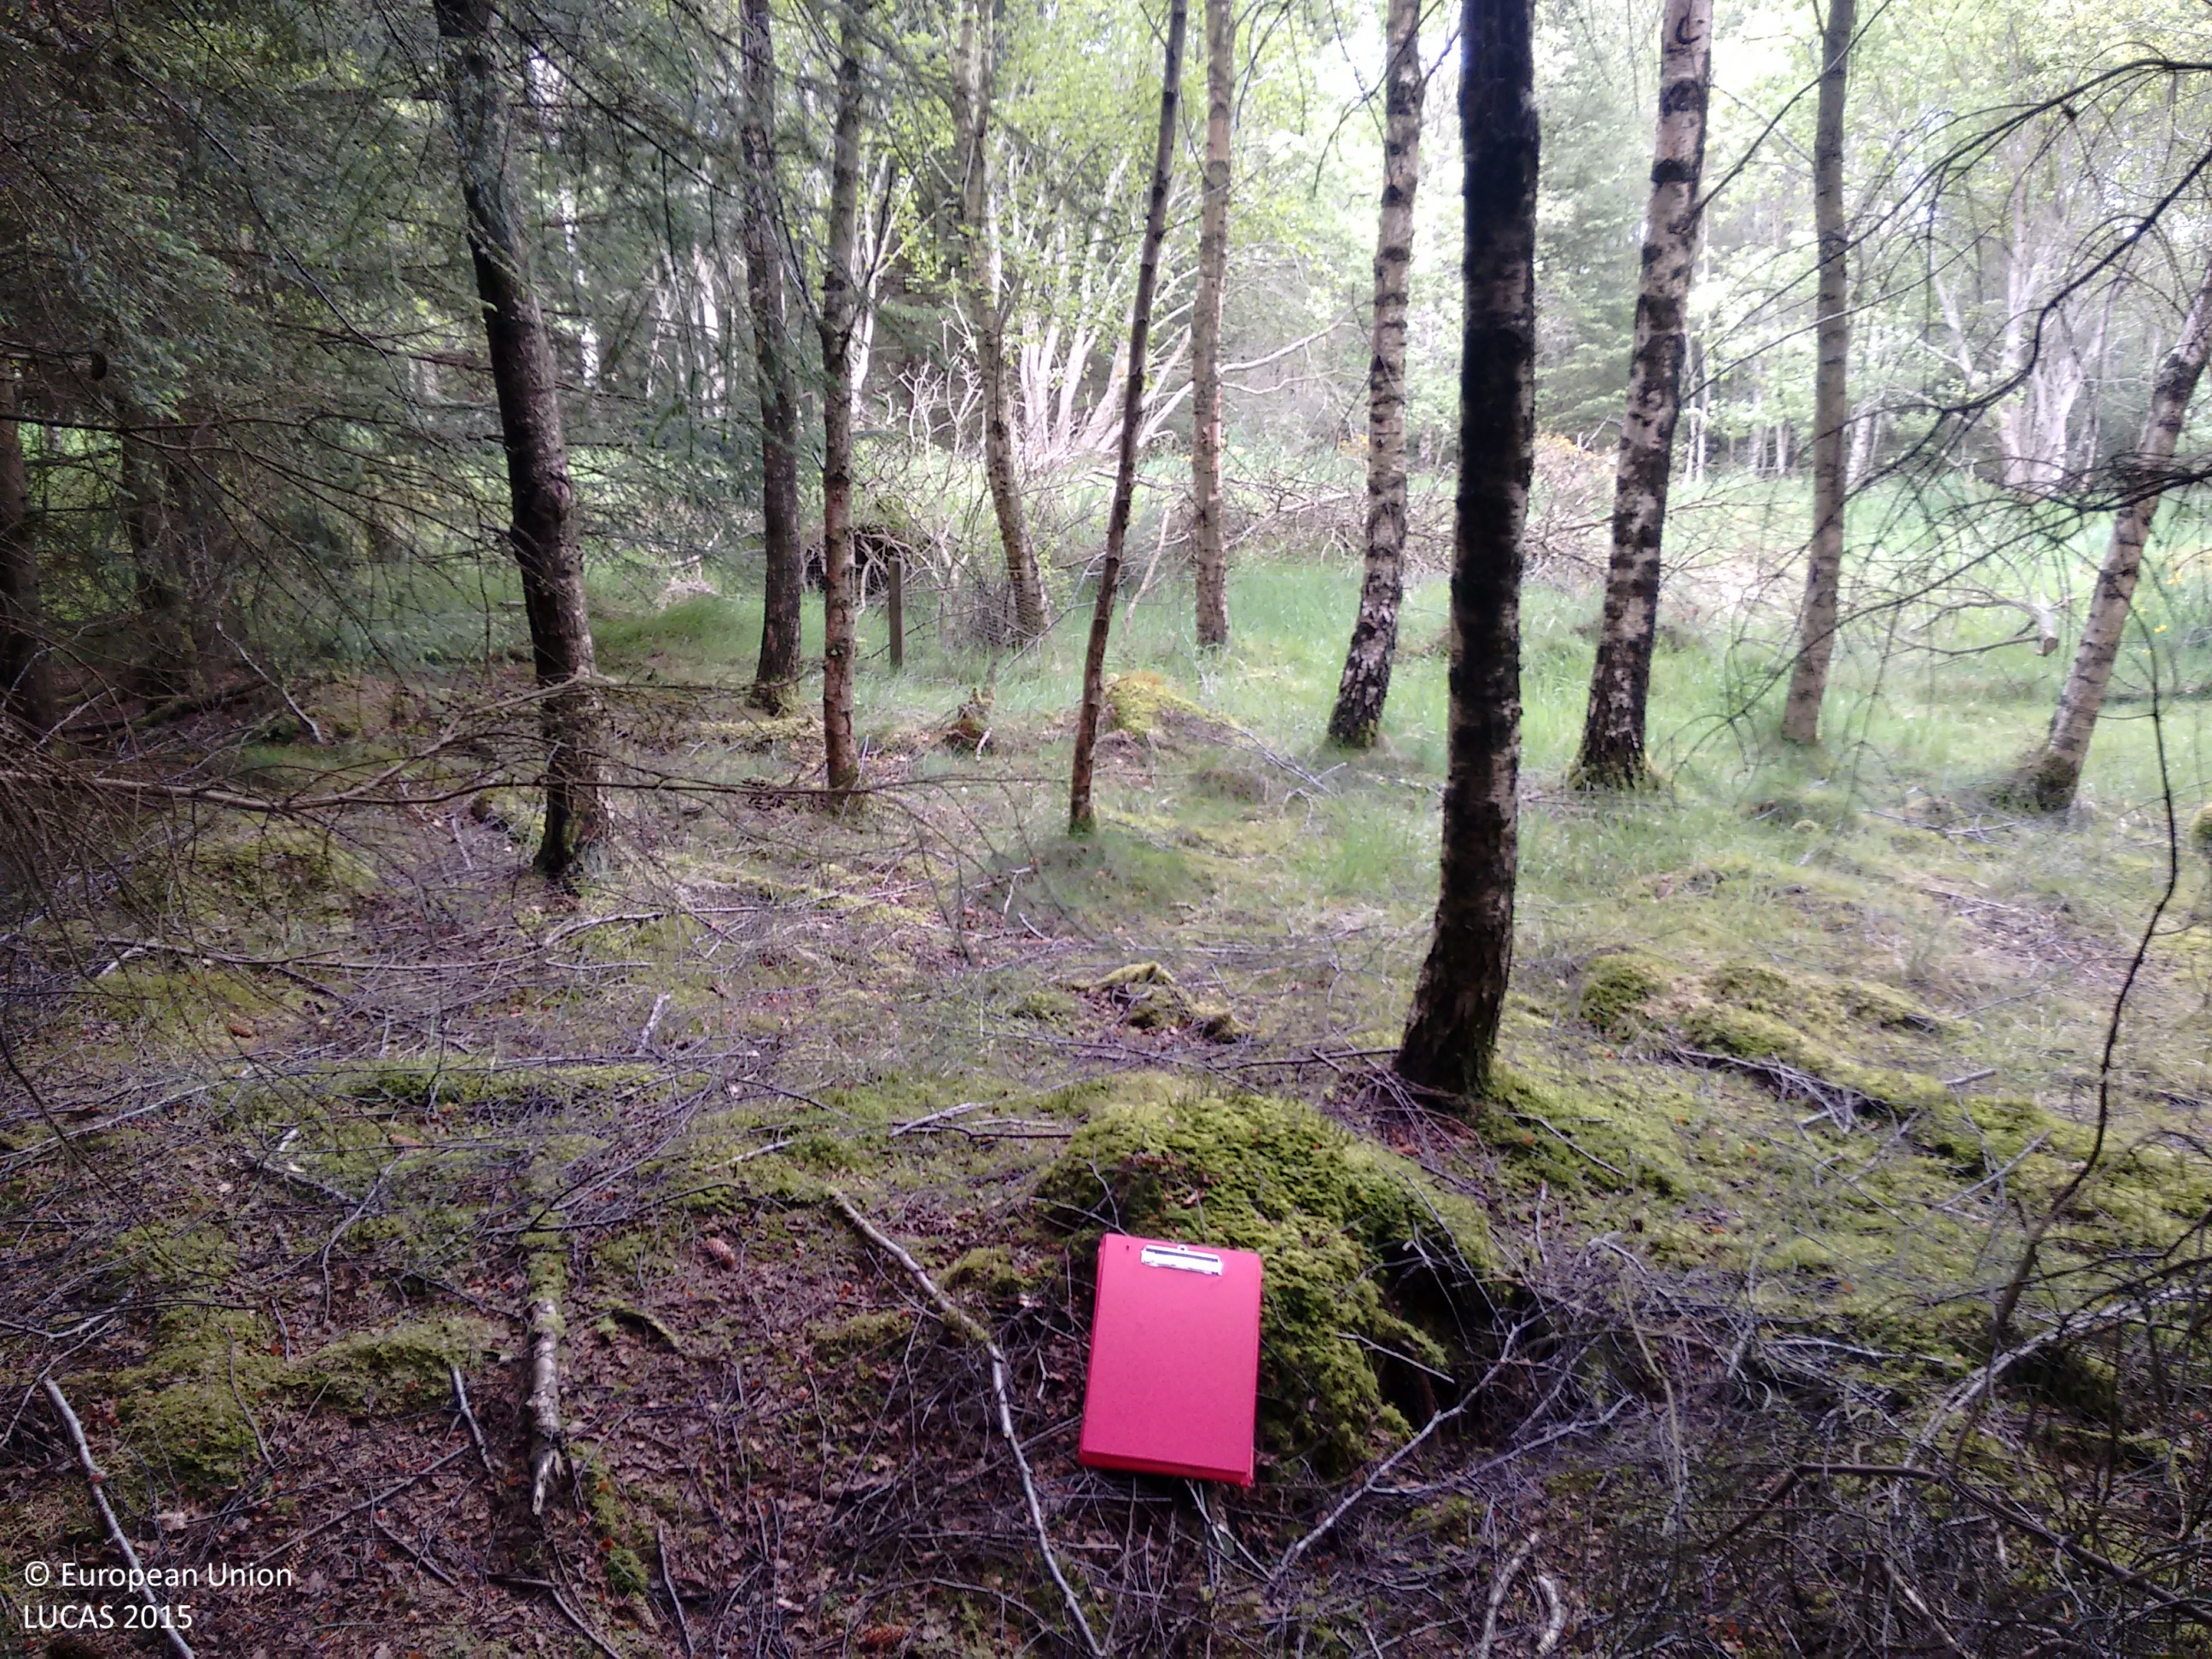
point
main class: Woodland
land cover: Spruce dominated coniferous woodland
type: exotic forest
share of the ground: > 75 %
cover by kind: coniferous forest trees 80 %, broadleaved forest trees 10 %, herbaceous plants 5 %, lichens and mosses 5 %
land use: Forestry
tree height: > 5 m
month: June
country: GB
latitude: 56.8043
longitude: -2.5856
